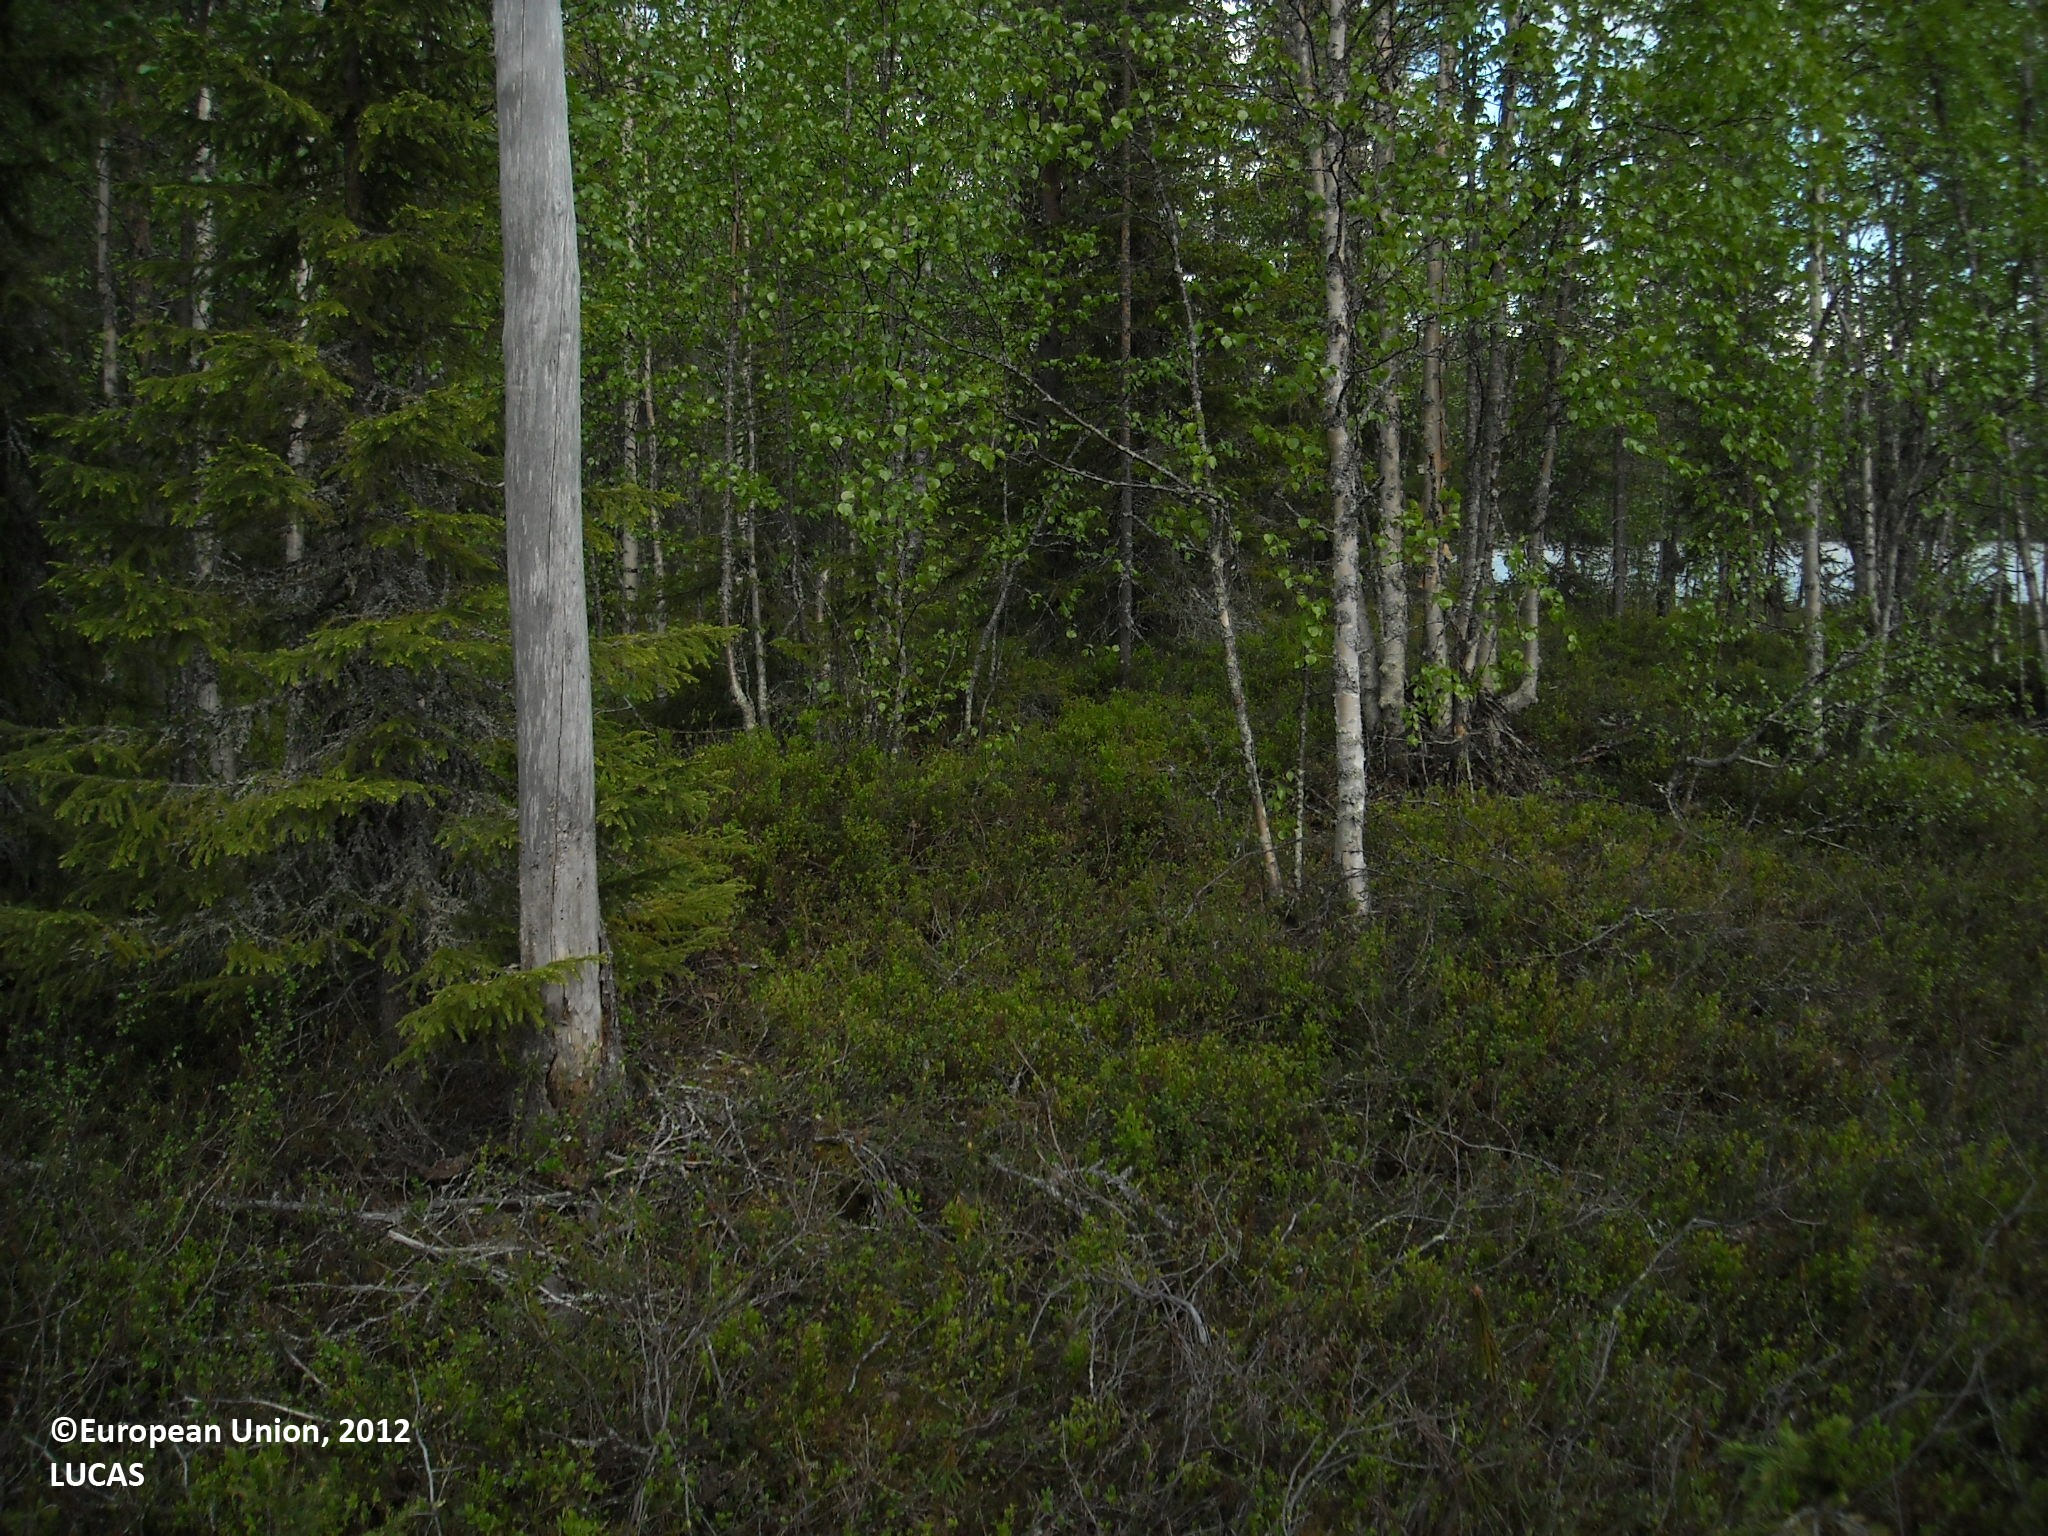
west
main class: Woodland
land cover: Pine dominated coniferous woodland
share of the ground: 25 - 50 %
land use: Forestry
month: June
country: FI
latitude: 65.7250
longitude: 27.9947
